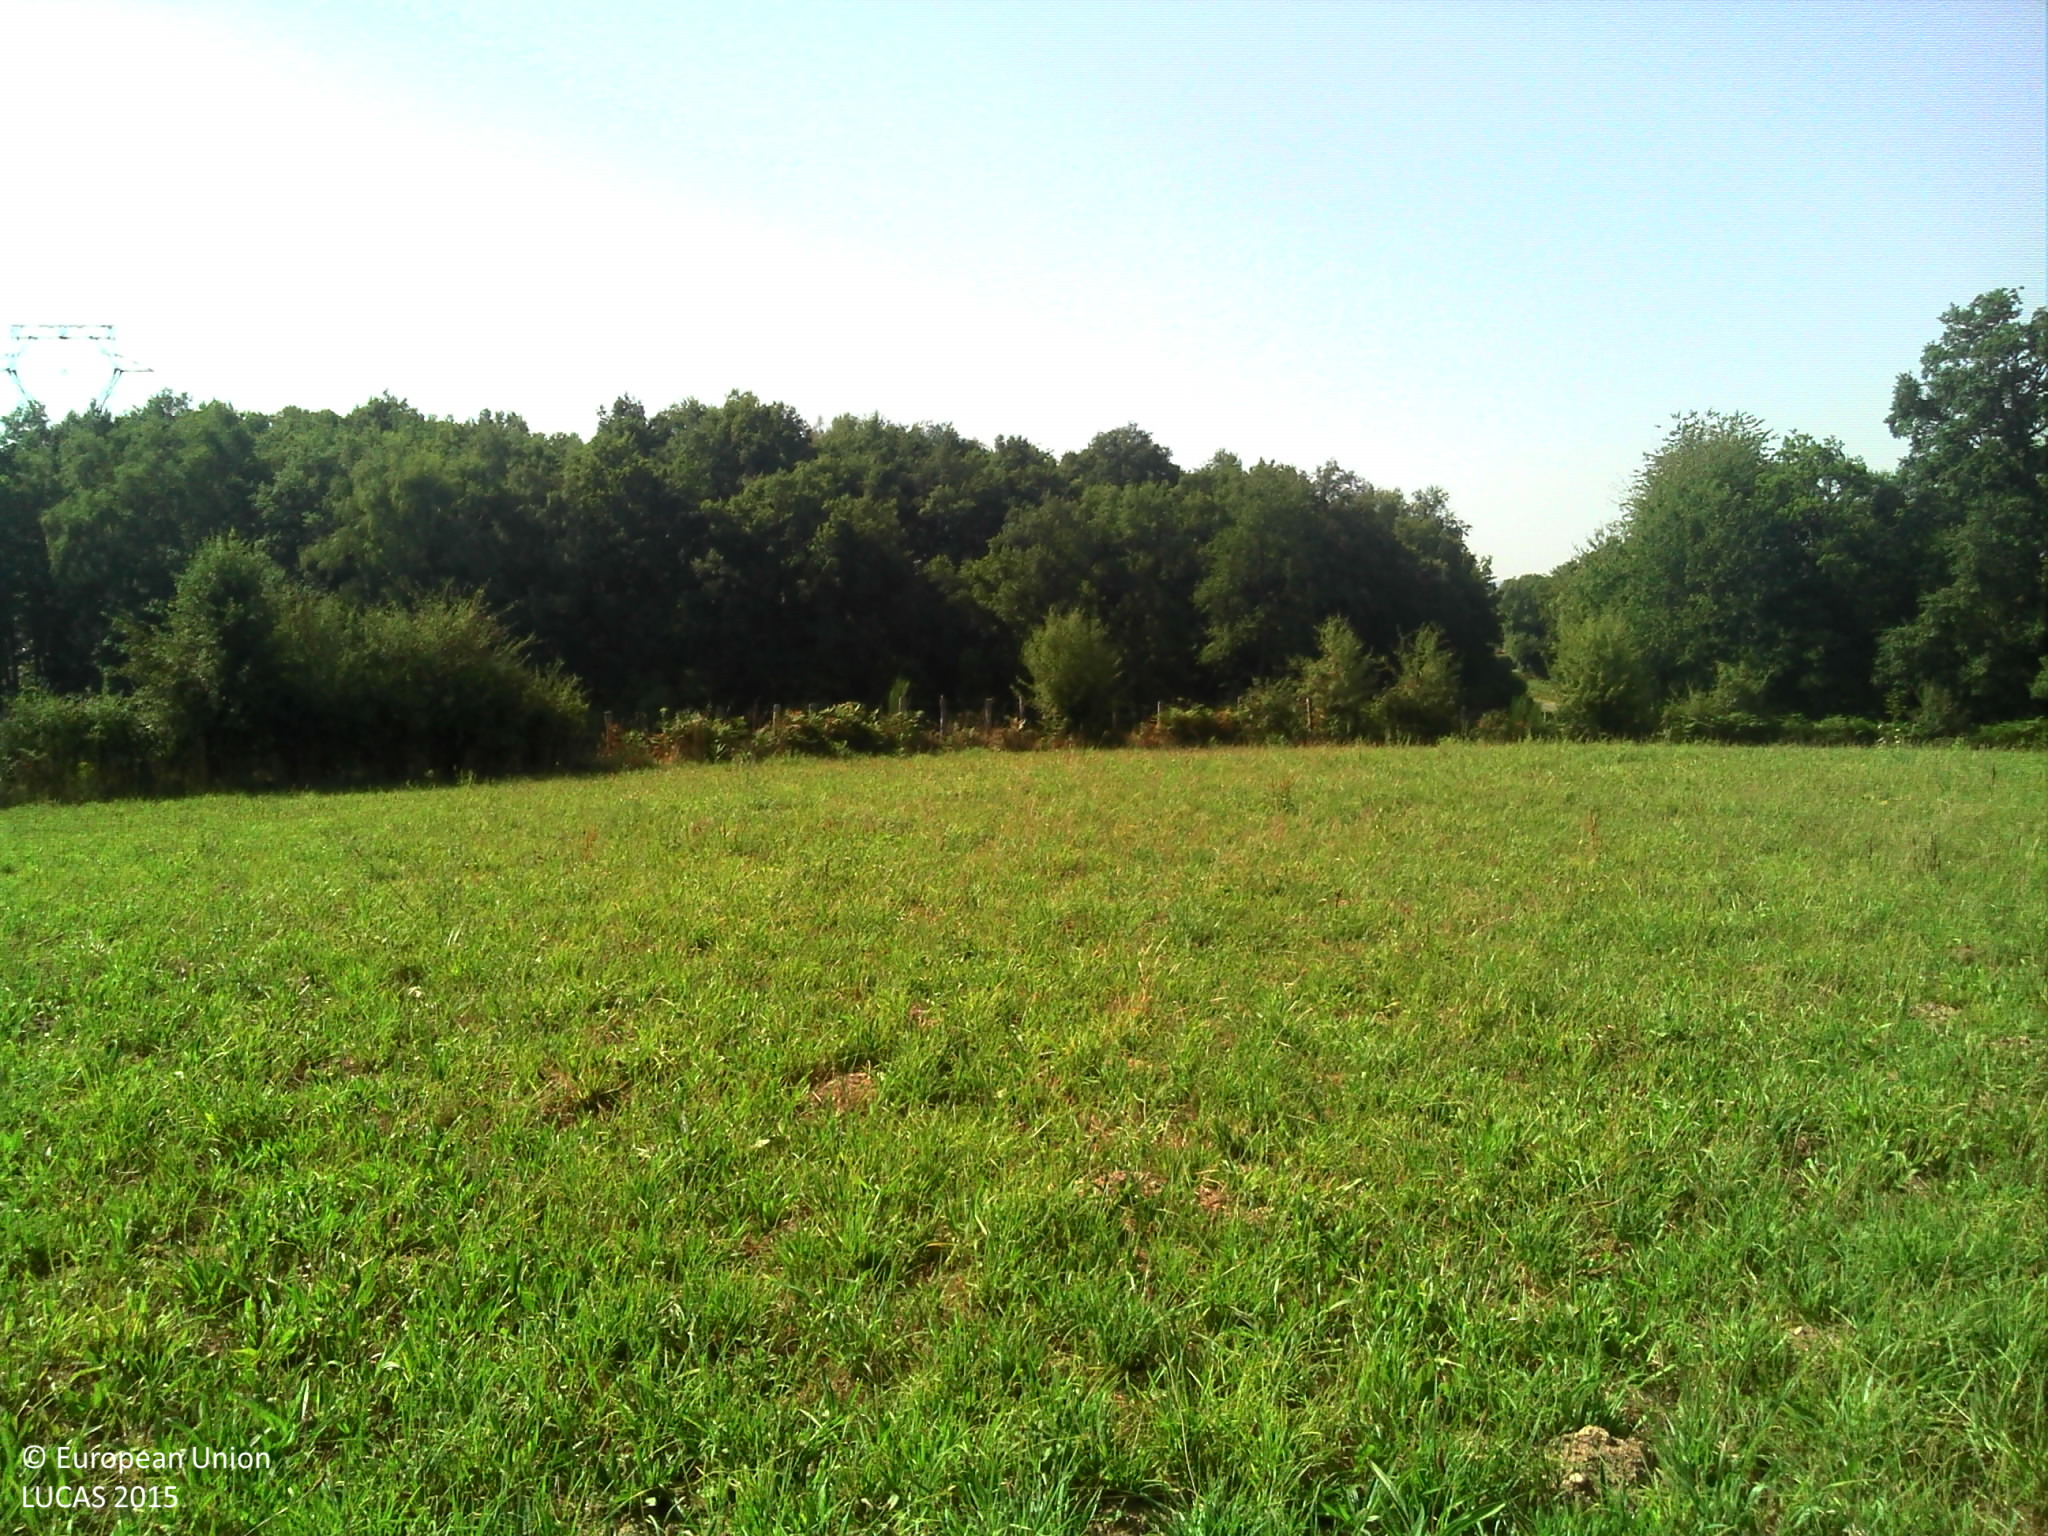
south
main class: Cropland
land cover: Temporary grasslands
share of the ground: > 75 %
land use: Agriculture (excluding fallow land and kitchen gardens)
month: August
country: FR
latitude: 46.2239
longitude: 1.6553
